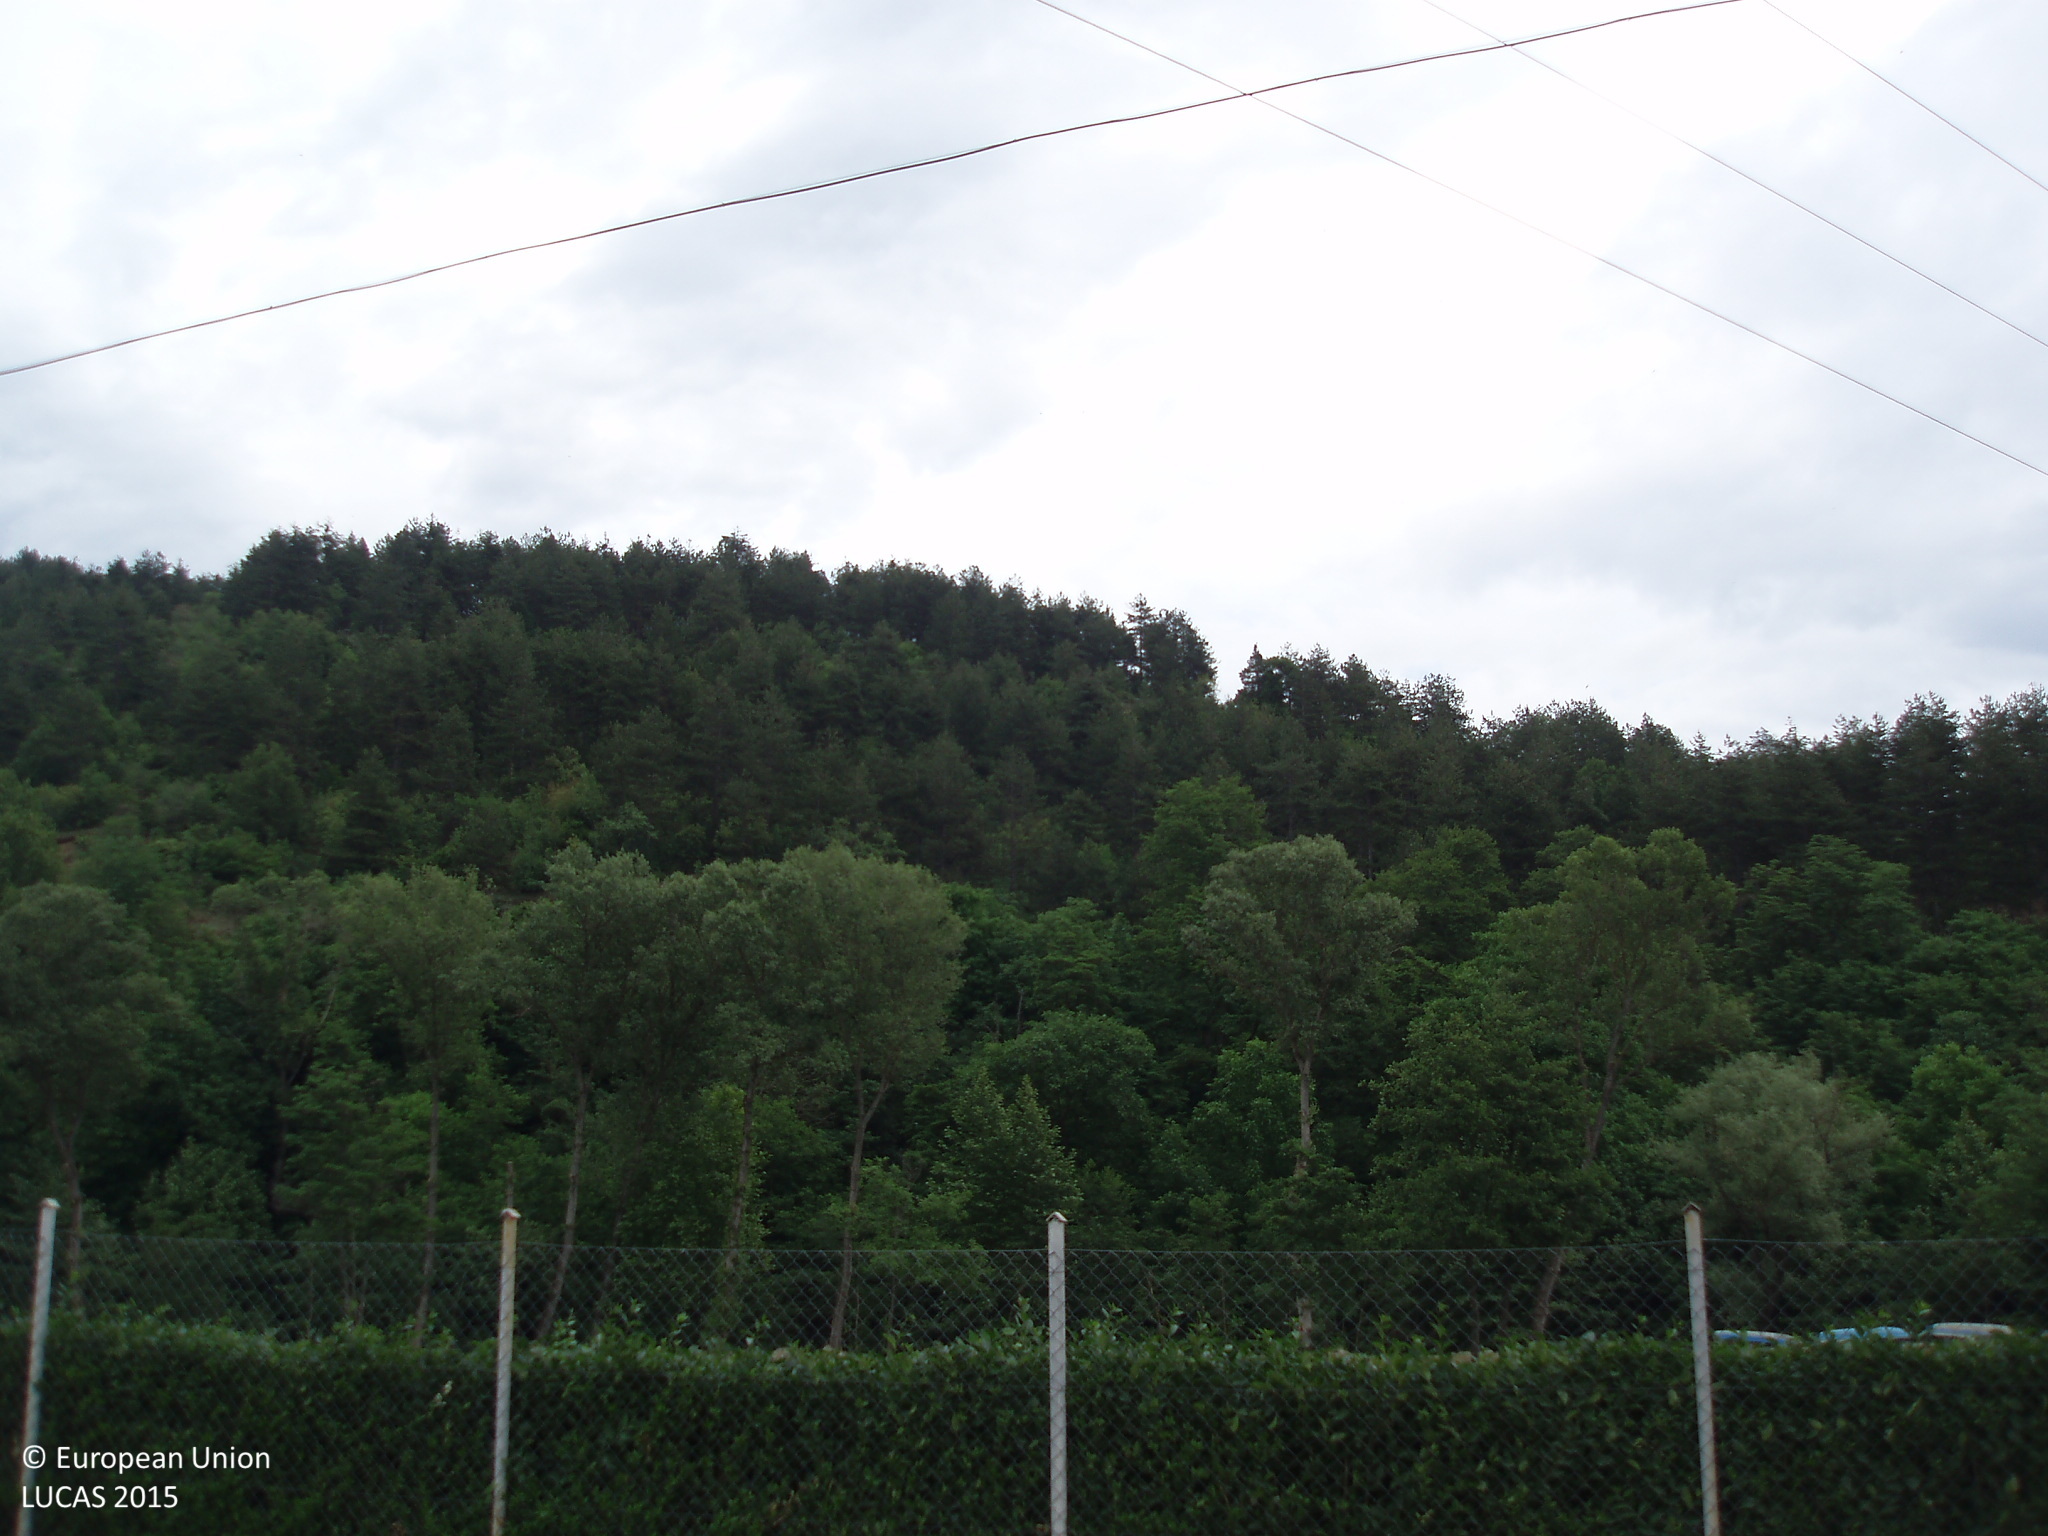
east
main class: Grassland
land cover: Spontaneously vegetated surfaces
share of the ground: > 75 %
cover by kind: herbaceous plants 100 %
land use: Abandoned areas
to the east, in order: Spontaneously vegetated surfaces; Fences; Managed hedges; Electric lines; Paved roads, cycling and walking lanes; Fences; Electric lines; Grassland with sparse tree/shrub cover; Inland fresh water bodies; Grassland with sparse tree/shrub cover; Broadleaved woodland; Pine dominated mixed woodland; Paved roads, cycling and walking lanes; Broadleaved woodland
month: June
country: BG
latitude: 41.6136
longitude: 23.7942
